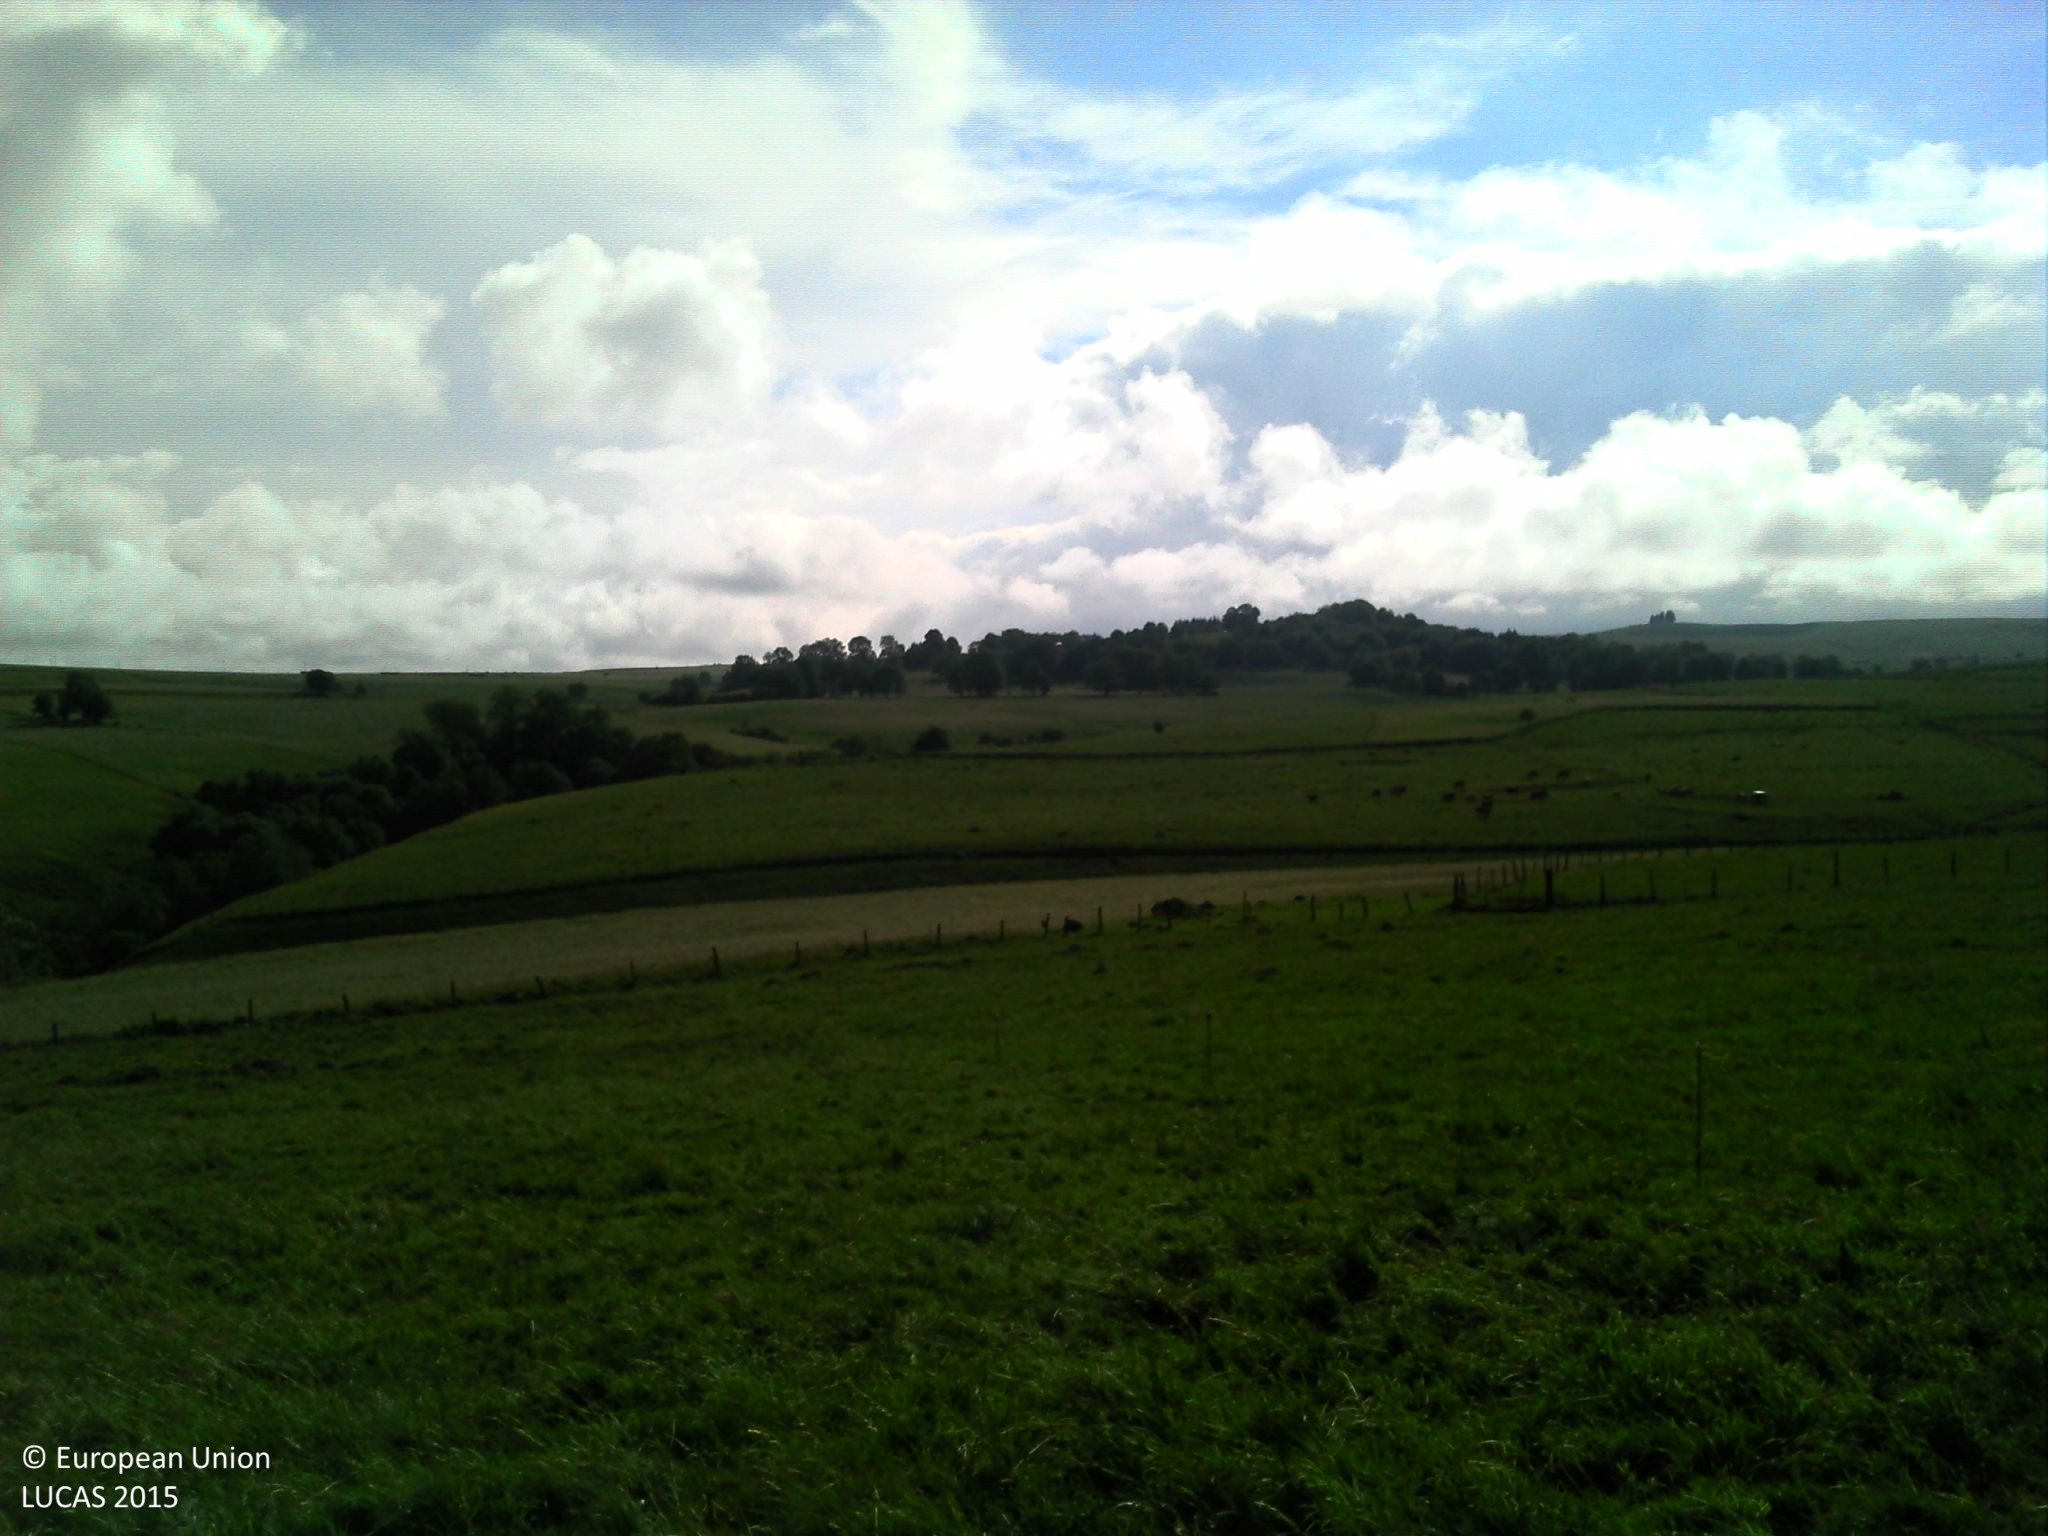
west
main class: Grassland
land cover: Grassland without tree/shrub cover
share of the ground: > 75 %
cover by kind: herbaceous plants 100 %
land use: Agriculture (excluding fallow land and kitchen gardens)
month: June
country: FR
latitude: 45.2295
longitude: 2.9066
